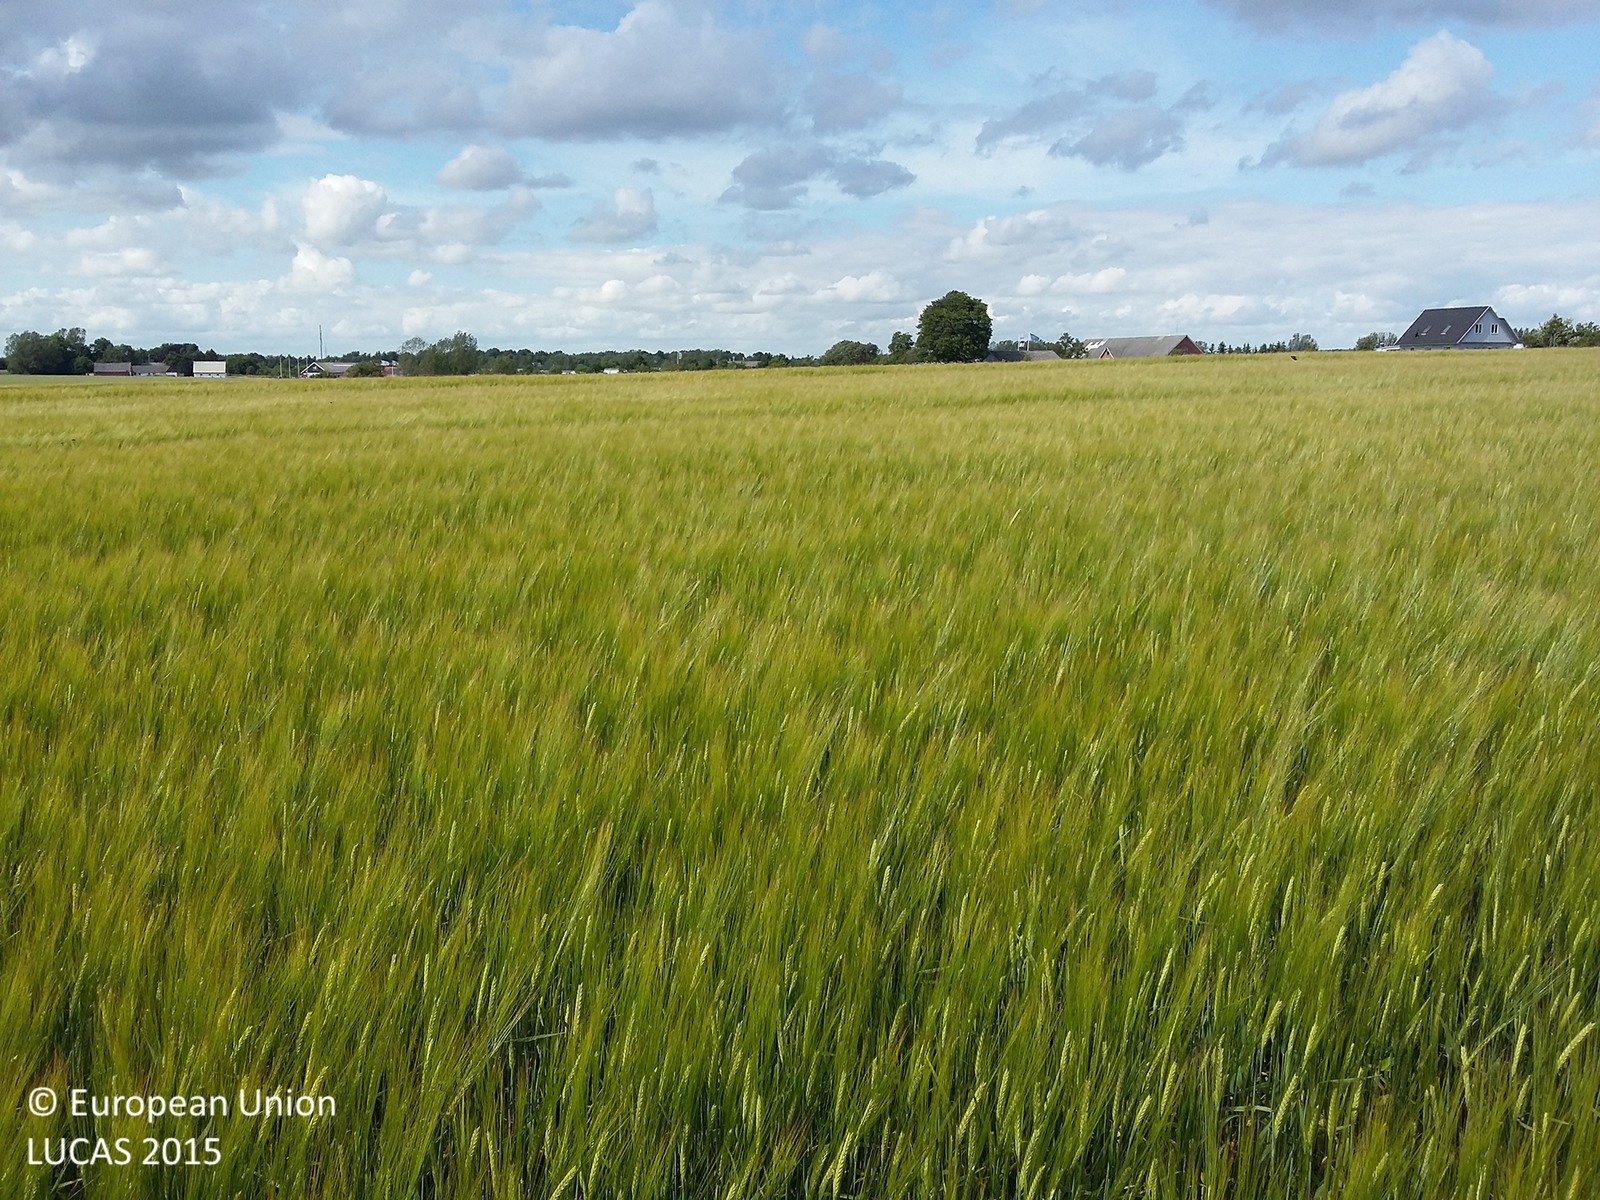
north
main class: Cropland
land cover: Barley
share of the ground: > 75 %
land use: Agriculture (excluding fallow land and kitchen gardens)
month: July
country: DK
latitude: 55.1867
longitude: 11.7735
